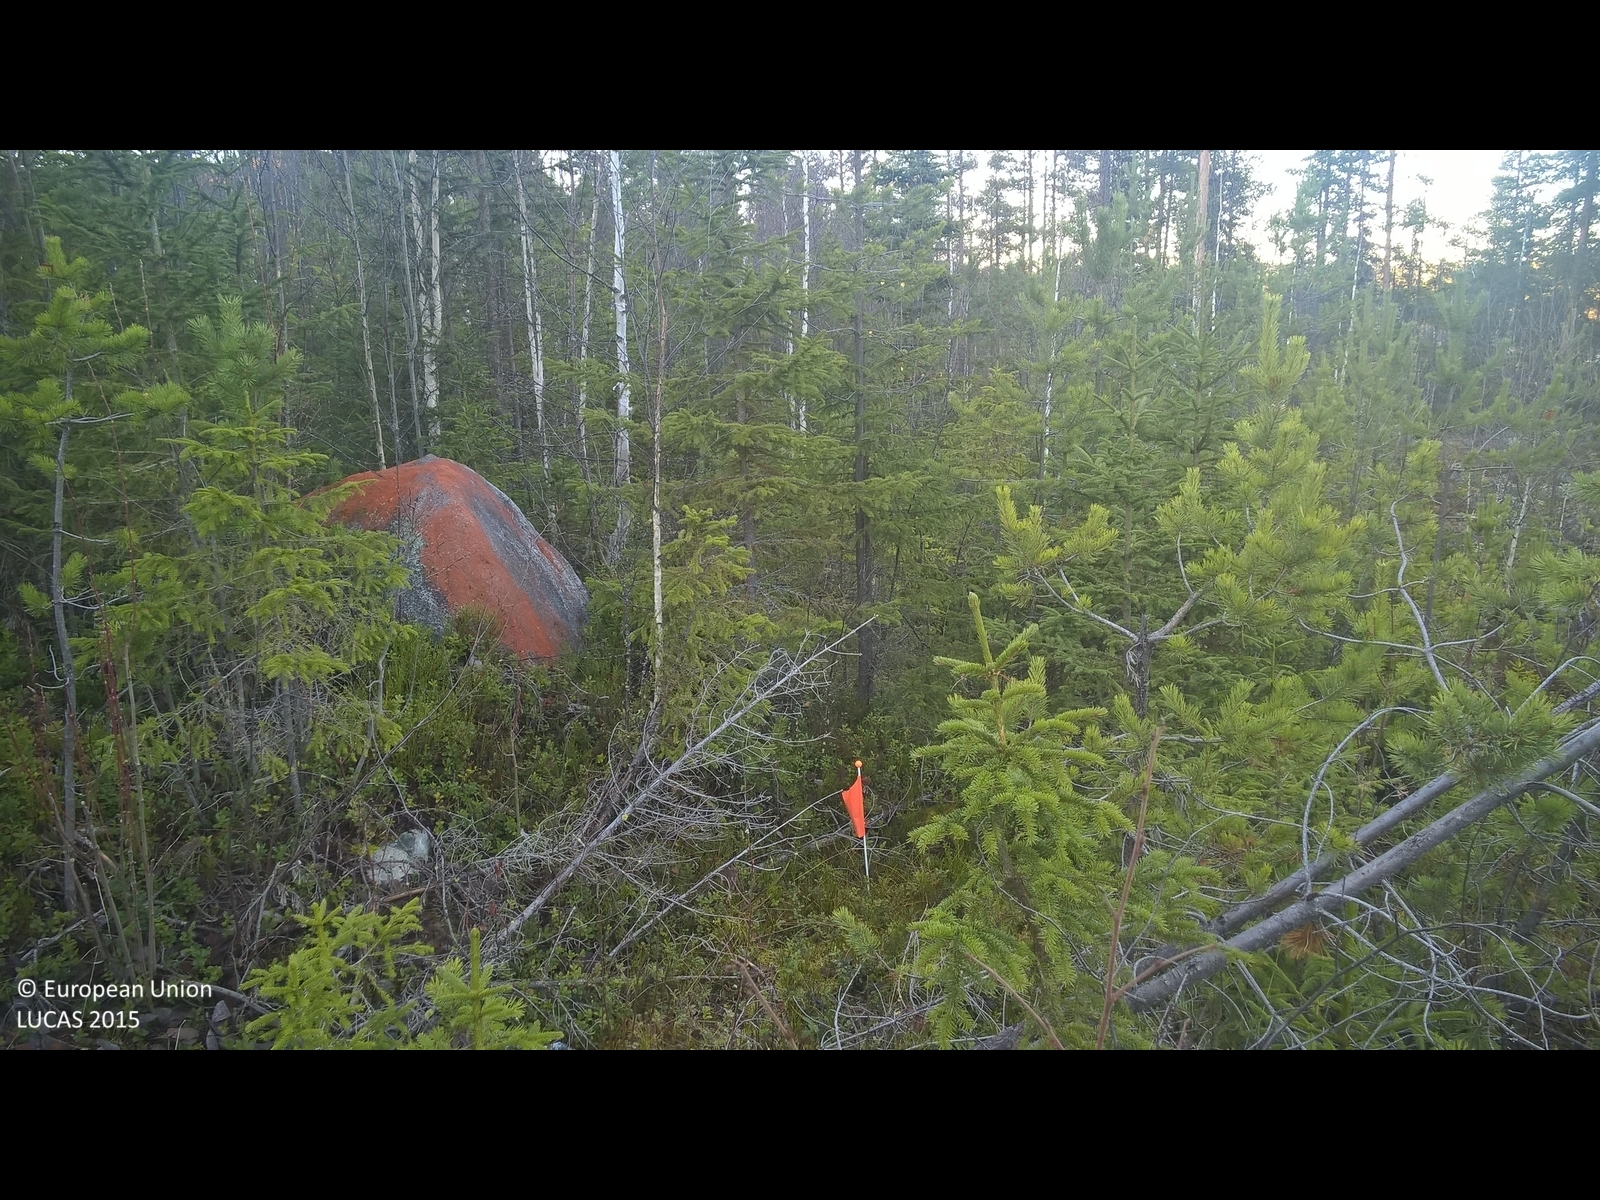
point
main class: Woodland
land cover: Other mixed woodland
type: boreal forest
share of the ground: 50 - 75 %
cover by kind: coniferous forest trees 40 %, lichens and mosses 40 %, broadleaved forest trees 20 %
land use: Forestry
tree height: < 5 m
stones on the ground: < 10 %
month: October
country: SE
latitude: 63.0803
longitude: 15.7775
